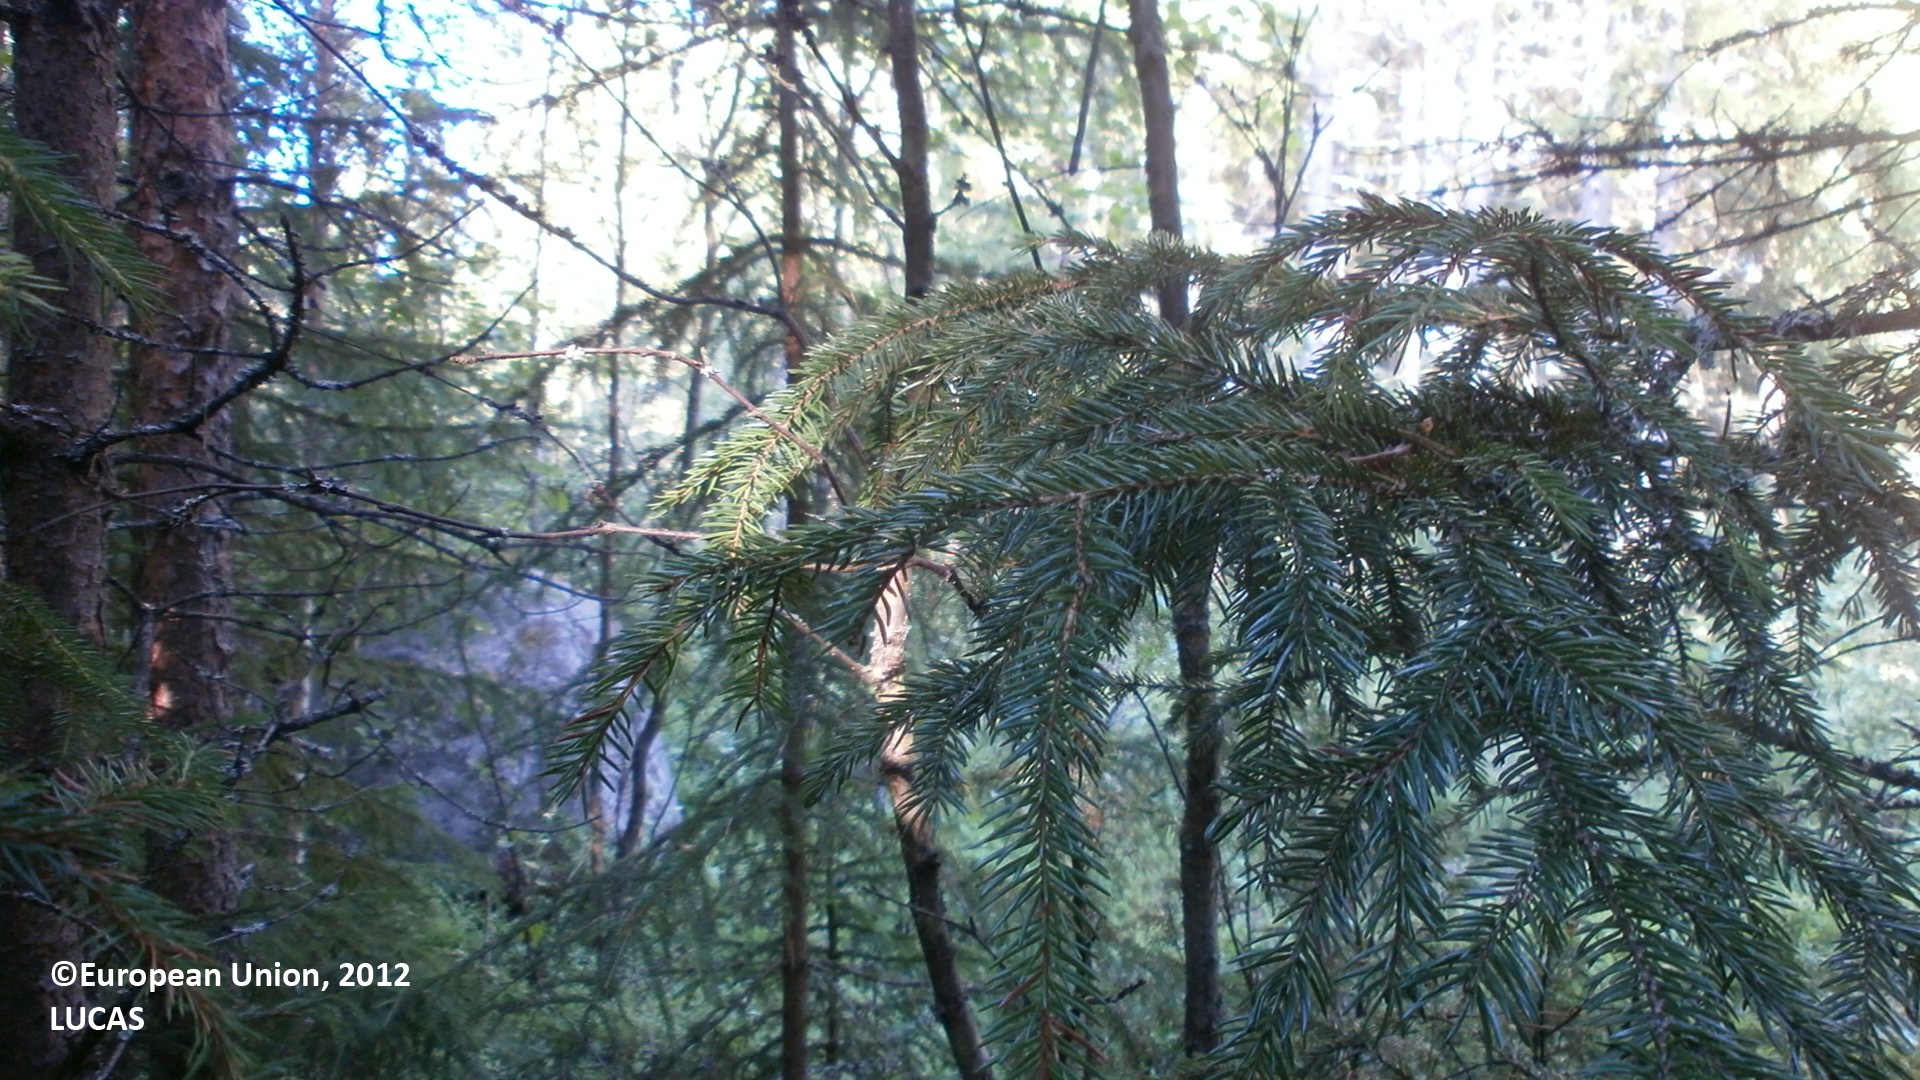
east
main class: Woodland
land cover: Pine dominated coniferous woodland
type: boreal forest
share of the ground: > 75 %
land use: Forestry
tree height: > 5 m
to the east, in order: Pine dominated coniferous woodland; Tracks; Spruce dominated coniferous woodland; Spruce dominated mixed woodland; Ditches and canals; Spruce dominated mixed woodland; Ditches and canals; Spruce dominated coniferous woodland; Tracks; Spruce dominated coniferous woodland; Tracks; Spruce dominated coniferous woodland; Pine dominated mixed woodland
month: July
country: FI
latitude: 64.1015
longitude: 23.6218
